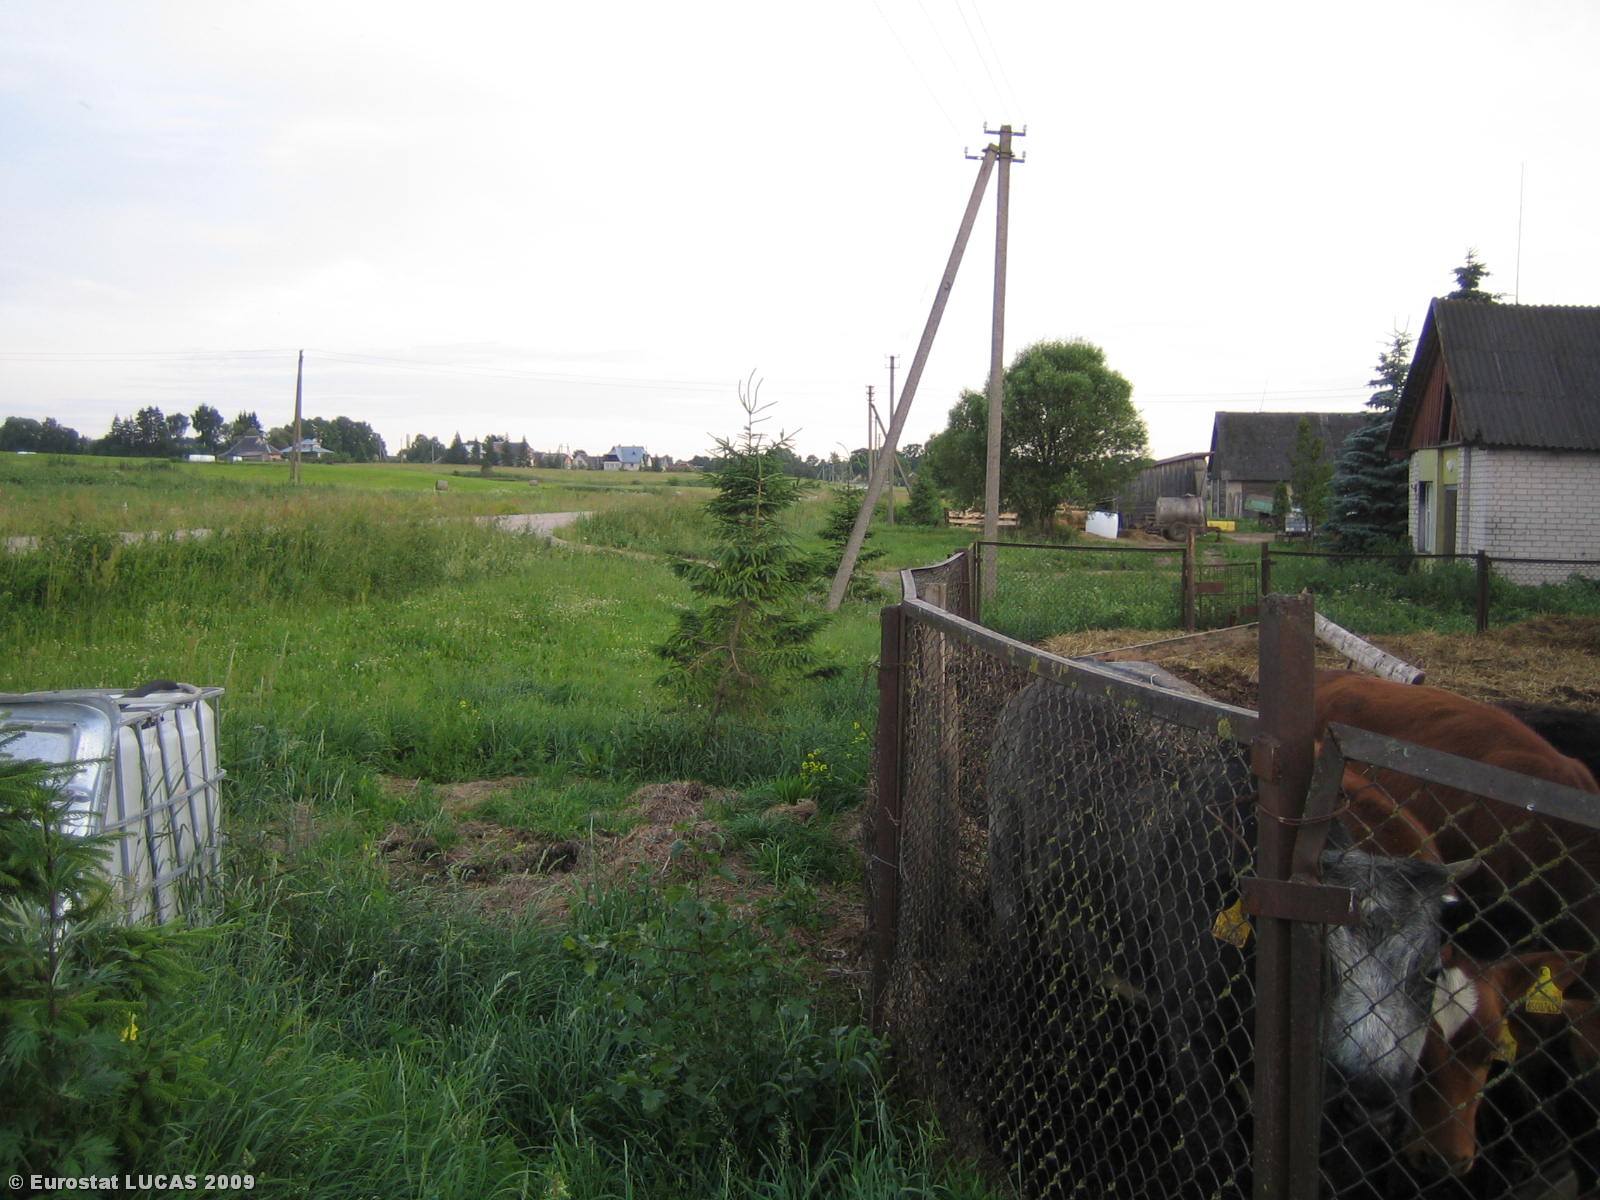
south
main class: Grassland
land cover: Grassland without tree/shrub cover
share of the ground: > 75 %
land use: Agriculture (excluding fallow land and kitchen gardens)
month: July
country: LT
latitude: 55.6486
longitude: 25.5877
